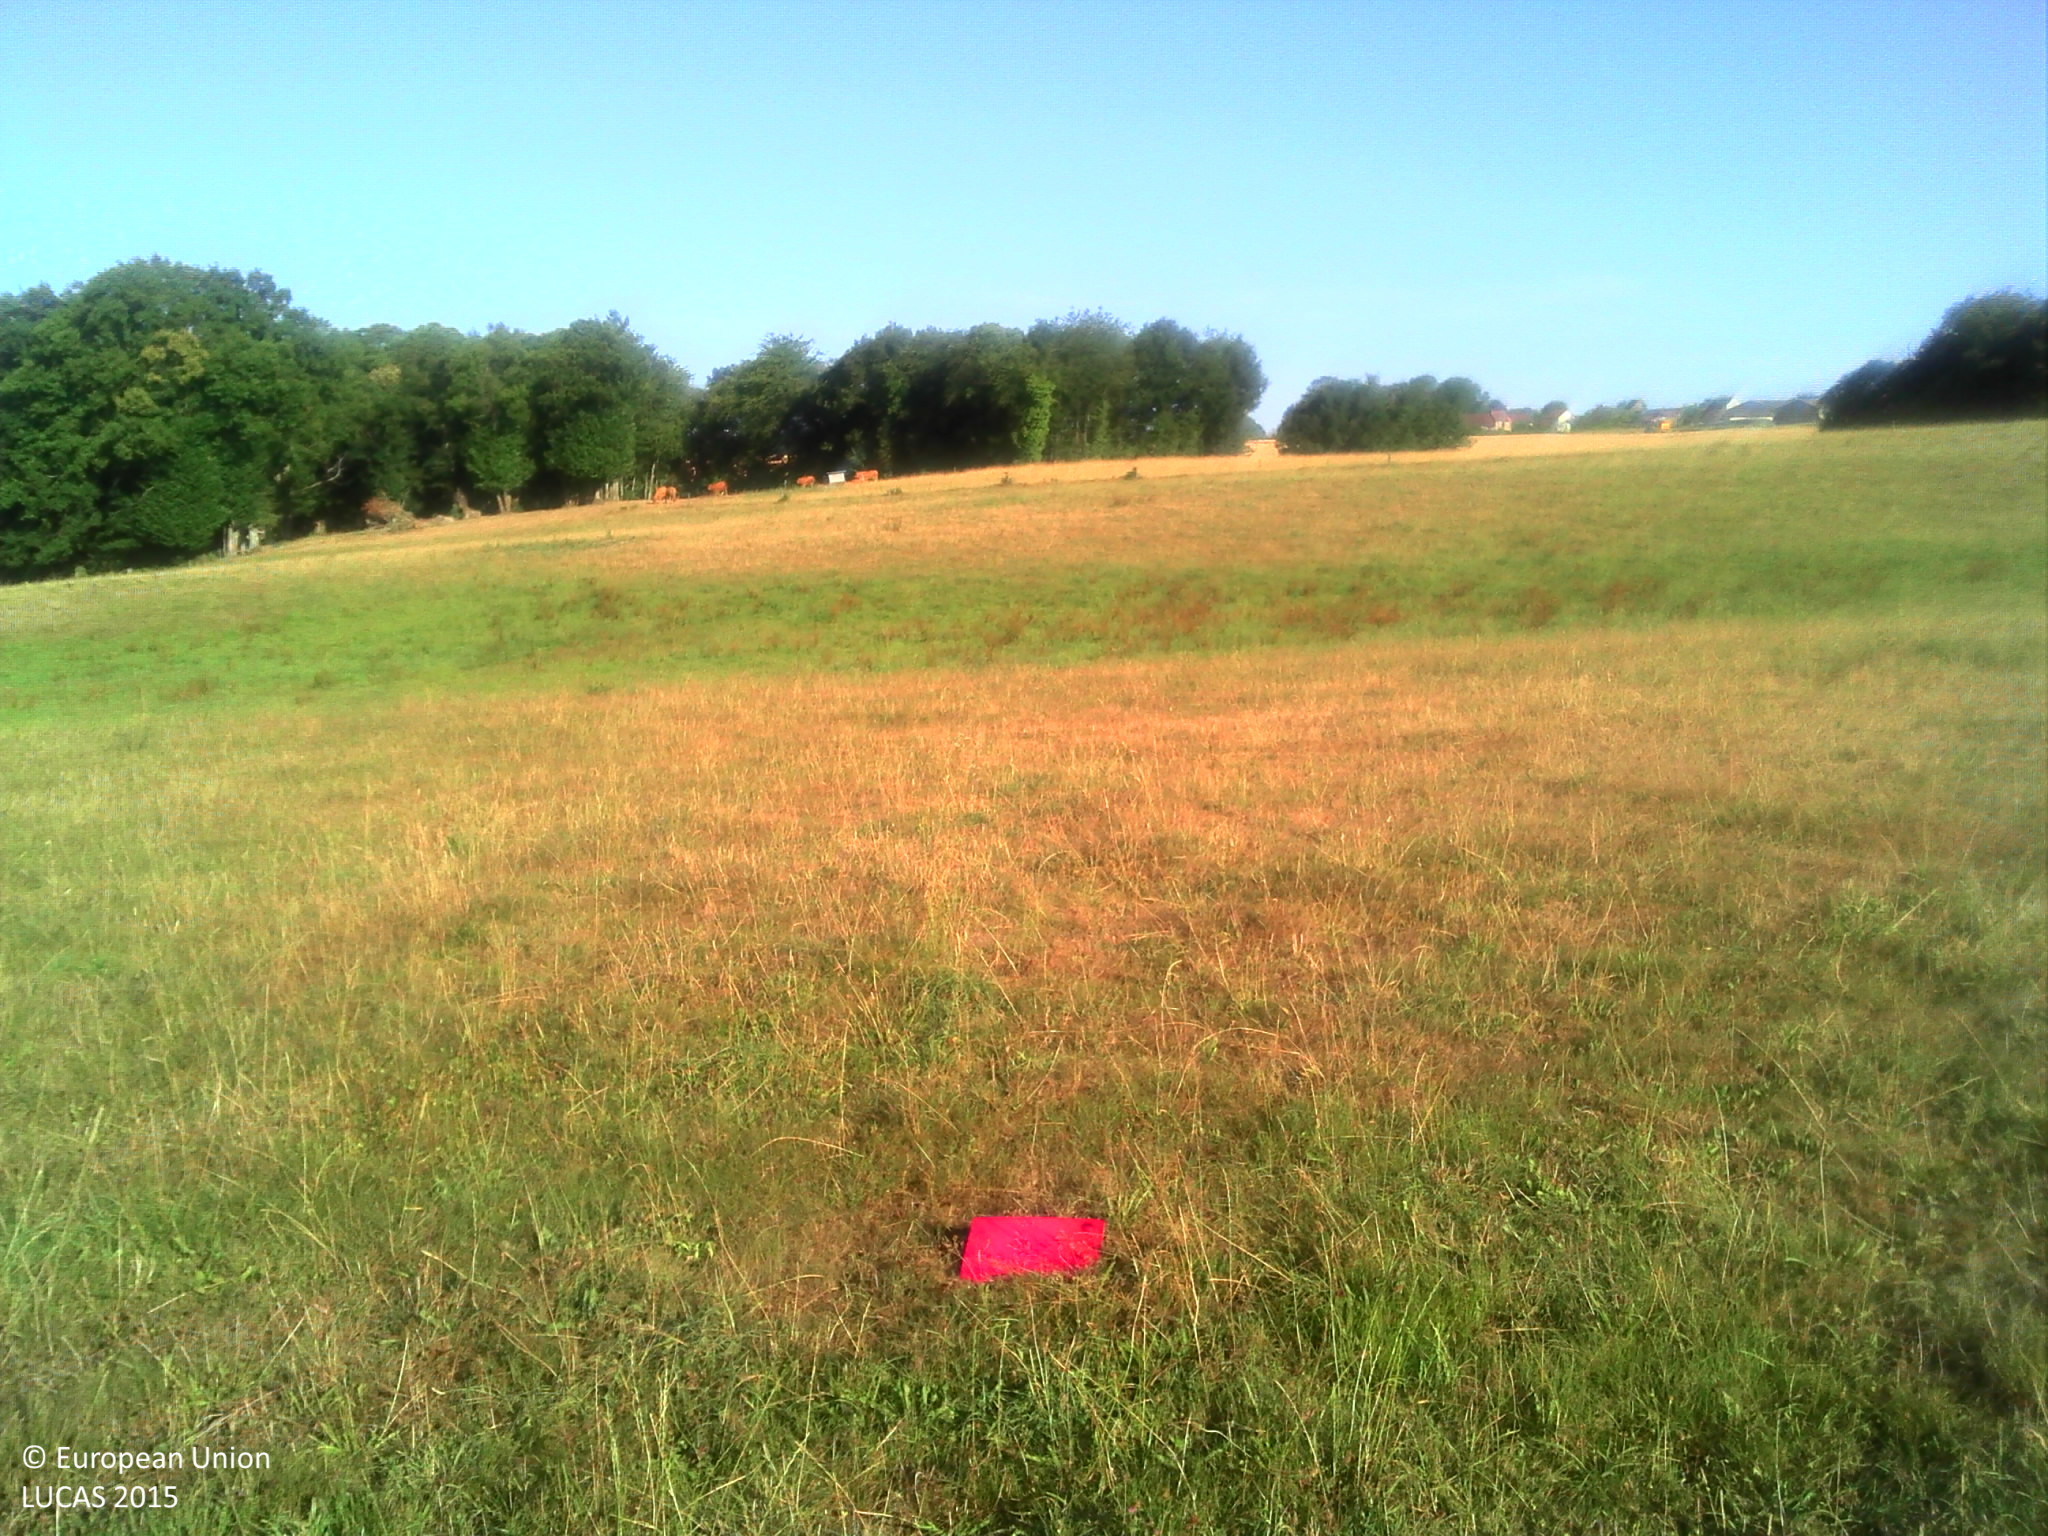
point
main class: Grassland
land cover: Grassland without tree/shrub cover
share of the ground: > 75 %
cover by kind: herbaceous plants 100 %
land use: Agriculture (excluding fallow land and kitchen gardens)
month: July
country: FR
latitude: 46.2397
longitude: 1.6267
